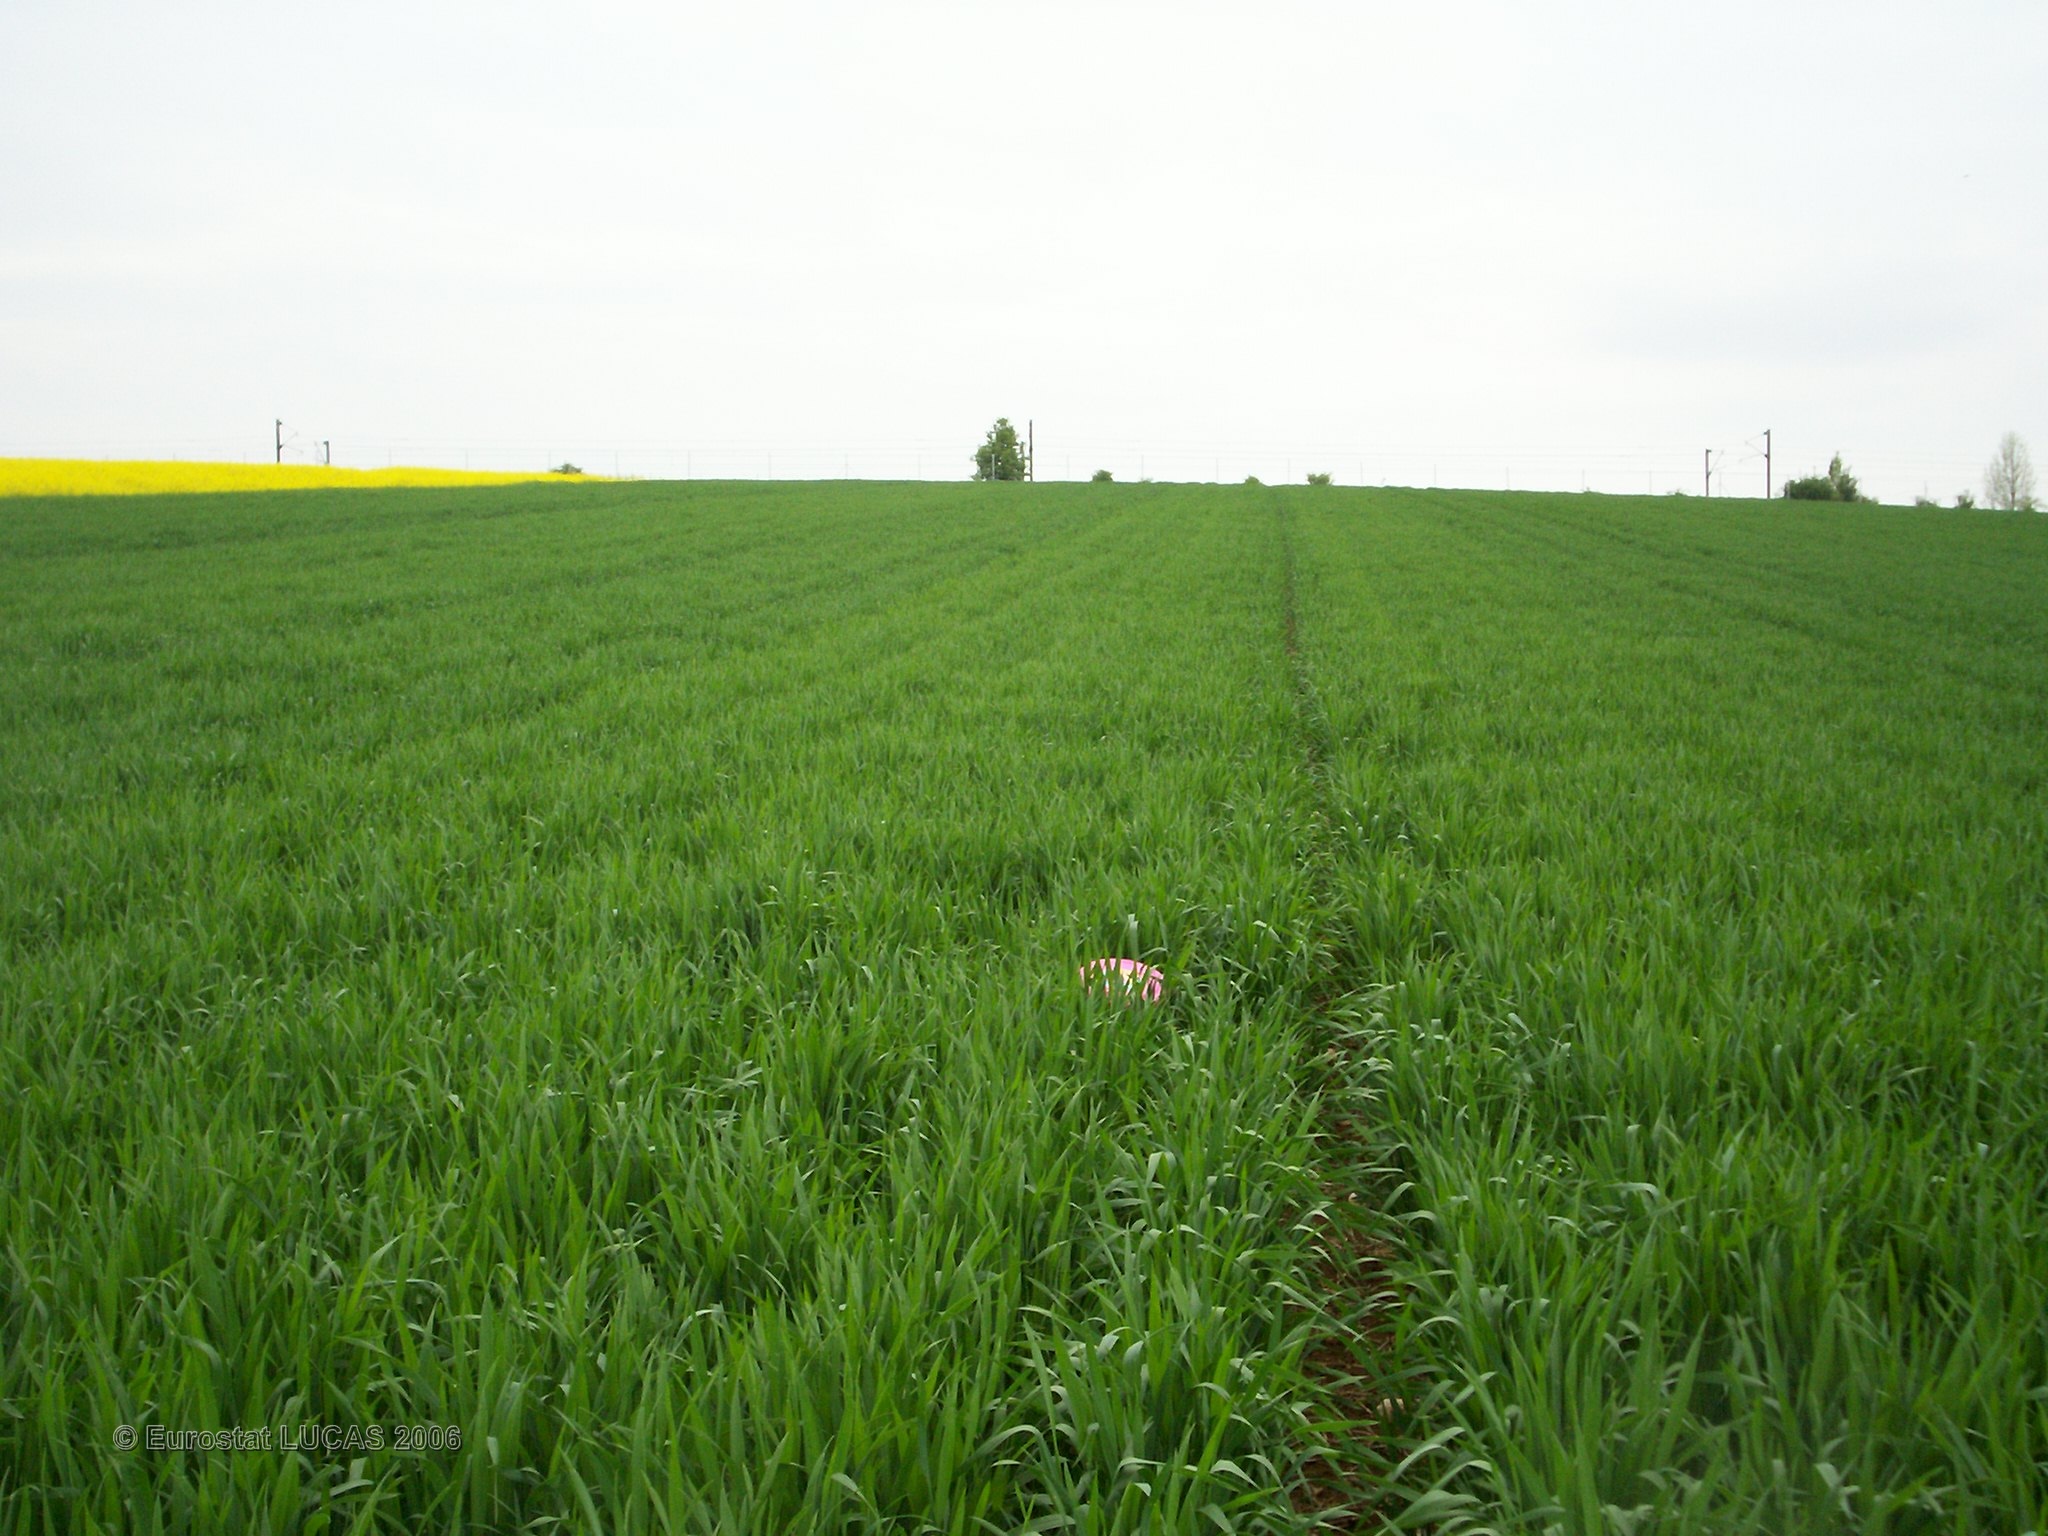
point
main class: Cropland
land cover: Common wheat
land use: Agriculture (excluding fallow land and kitchen gardens)
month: May
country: FR
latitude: 47.8240
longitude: 3.9728
